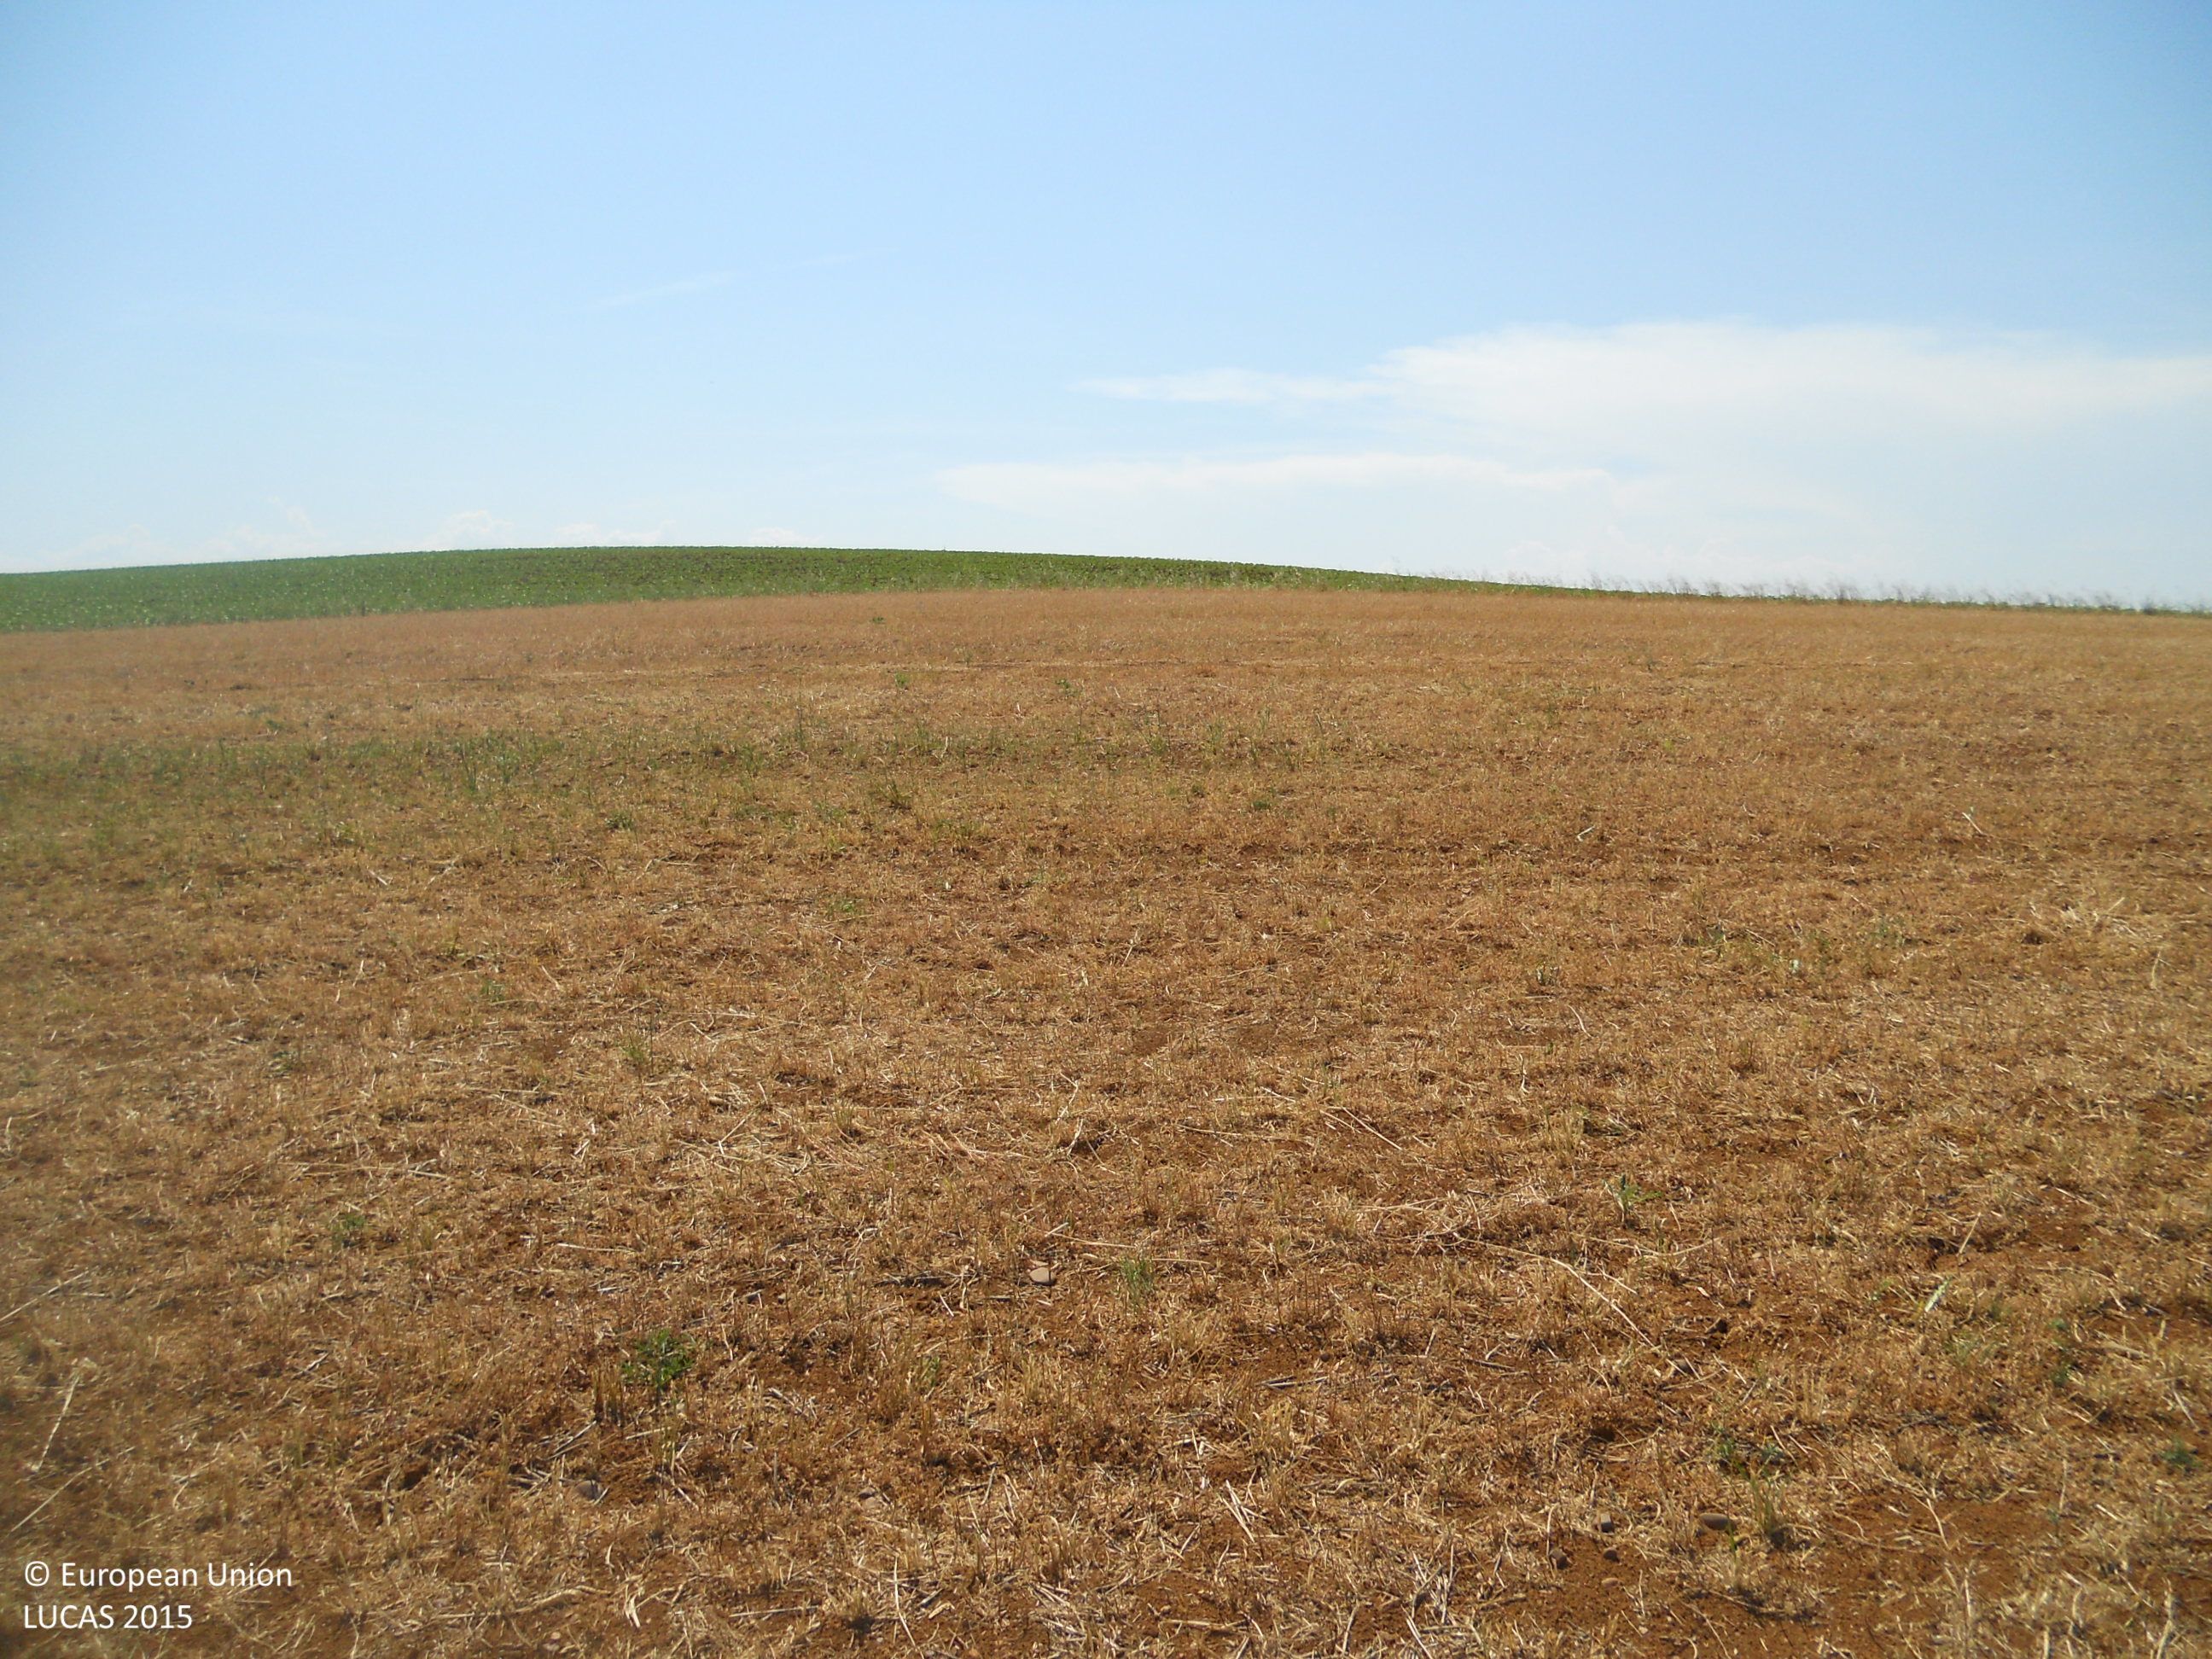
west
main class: Cropland
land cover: Mixed cereals for fodder
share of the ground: < 10 %
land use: Agriculture (excluding fallow land and kitchen gardens)
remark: Harvested field
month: June
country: ES
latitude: 42.1897
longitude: -5.4805
